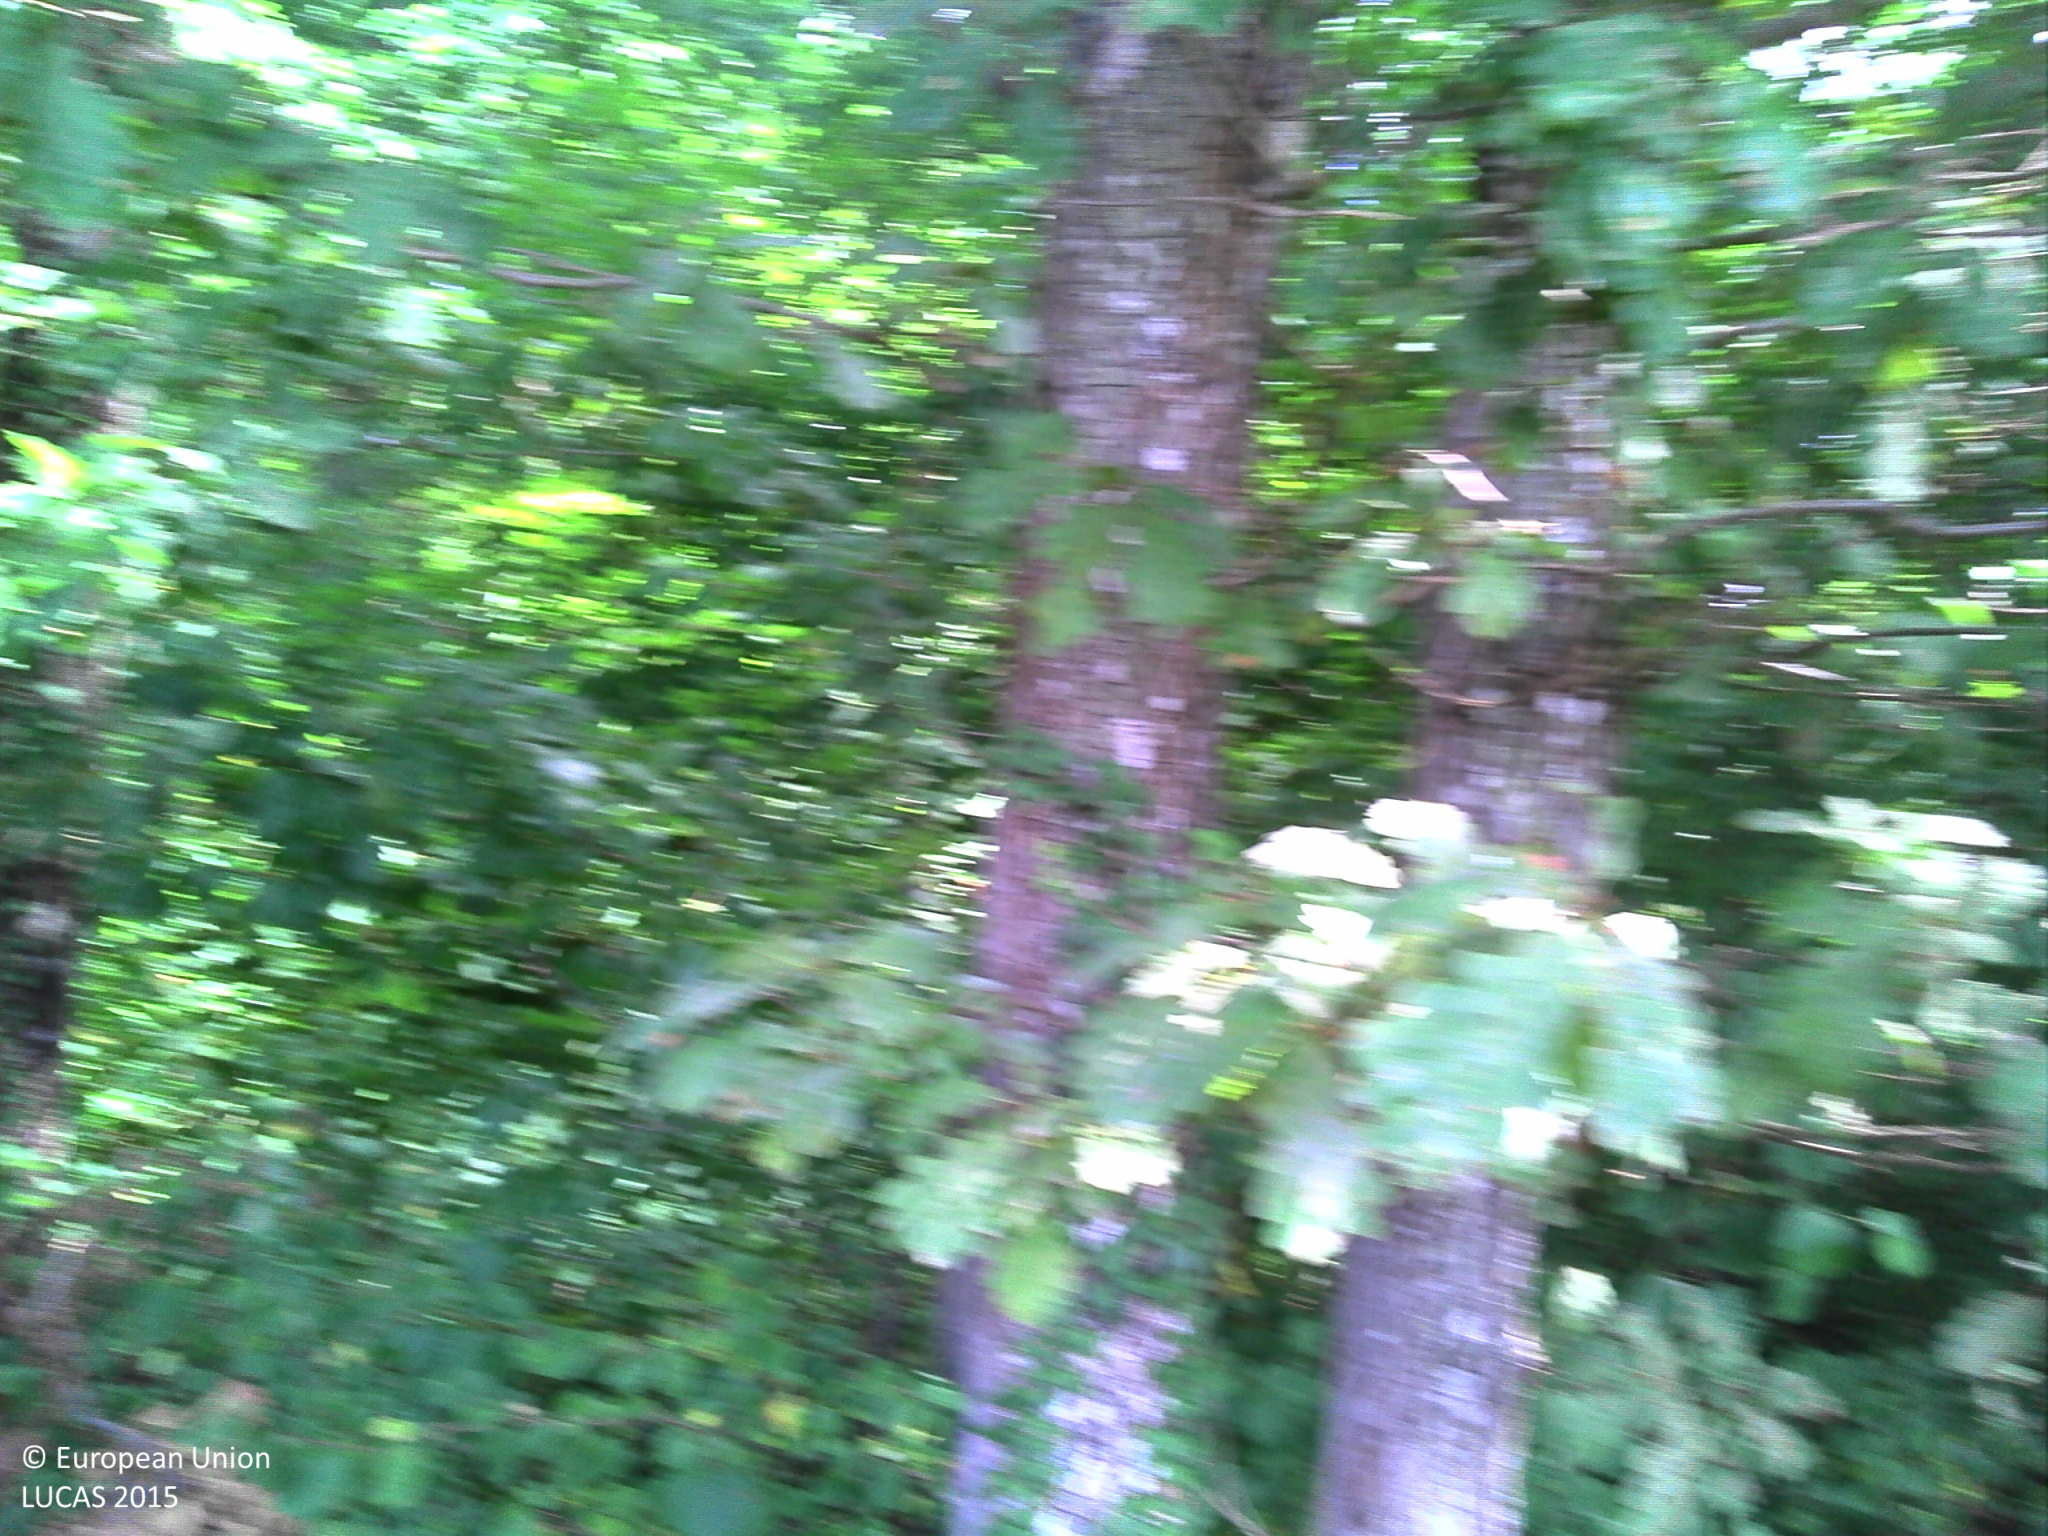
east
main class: Woodland
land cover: Broadleaved woodland
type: acidophilous oak and oak-birch forest
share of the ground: > 75 %
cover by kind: broadleaved forest trees 50 %, shrubs 30 %, herbaceous plants 20 %
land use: Forestry
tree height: > 5 m
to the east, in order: Broadleaved woodland; Tracks; Pine dominated mixed woodland; Ditches and canals; Pine dominated mixed woodland
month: July
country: FR
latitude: 48.0542
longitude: 0.5721
